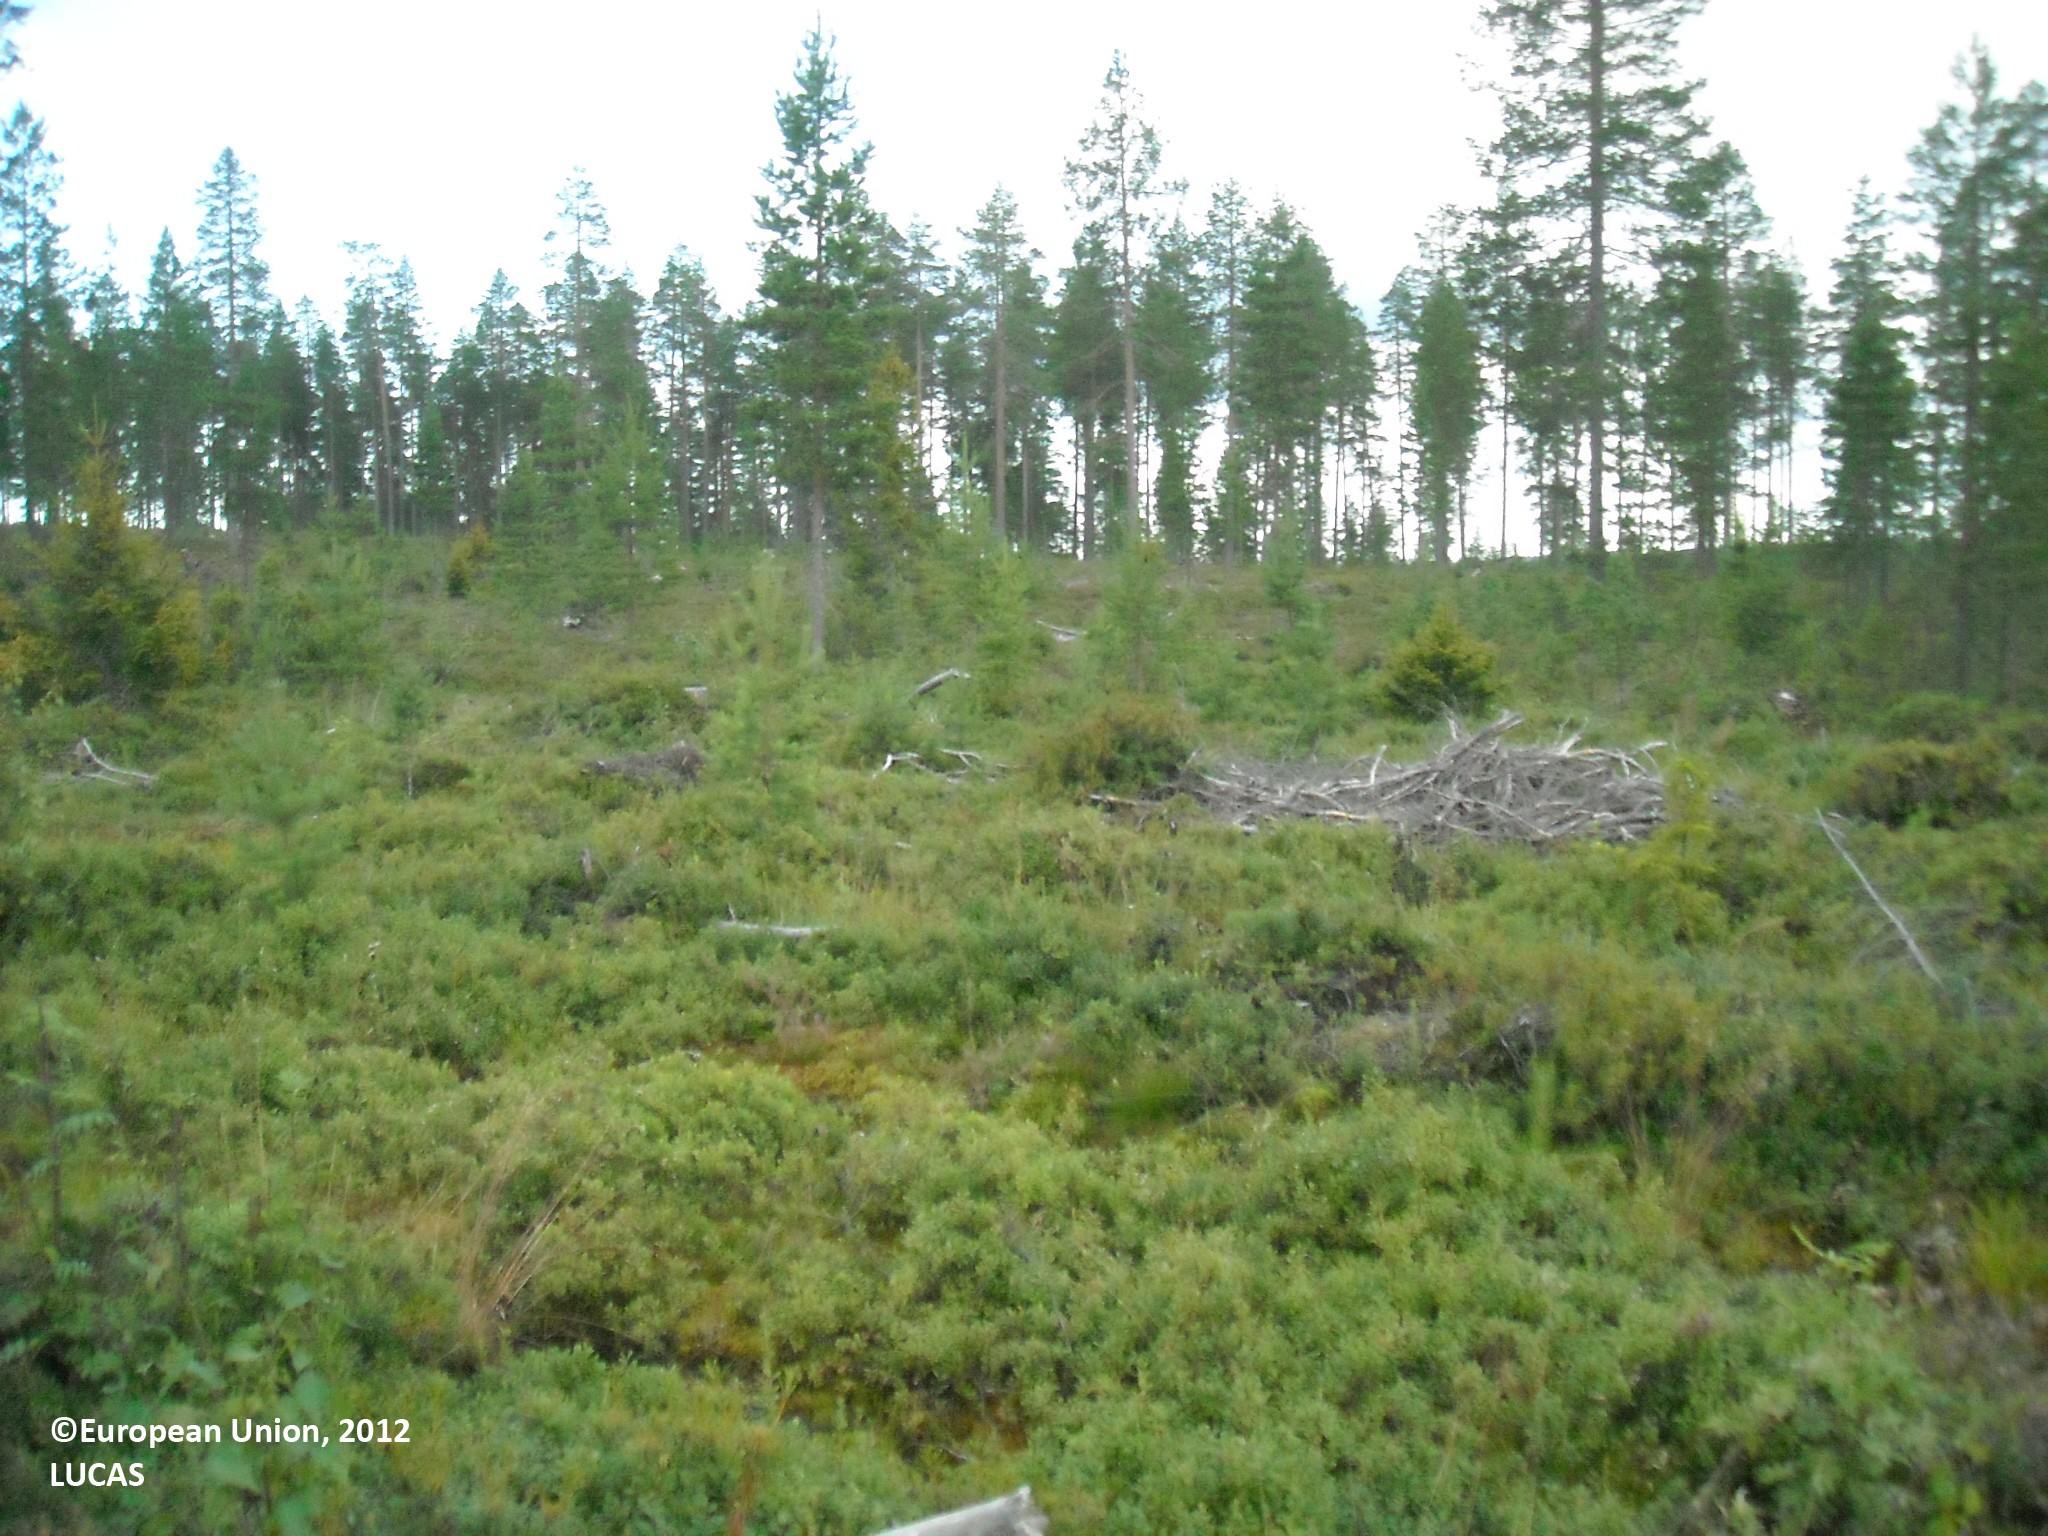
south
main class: Shrubland
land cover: Shrubland with sparse tree cover
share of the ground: > 75 %
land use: Forestry
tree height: > 5 m
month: August
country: FI
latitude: 65.1950
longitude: 27.7217
